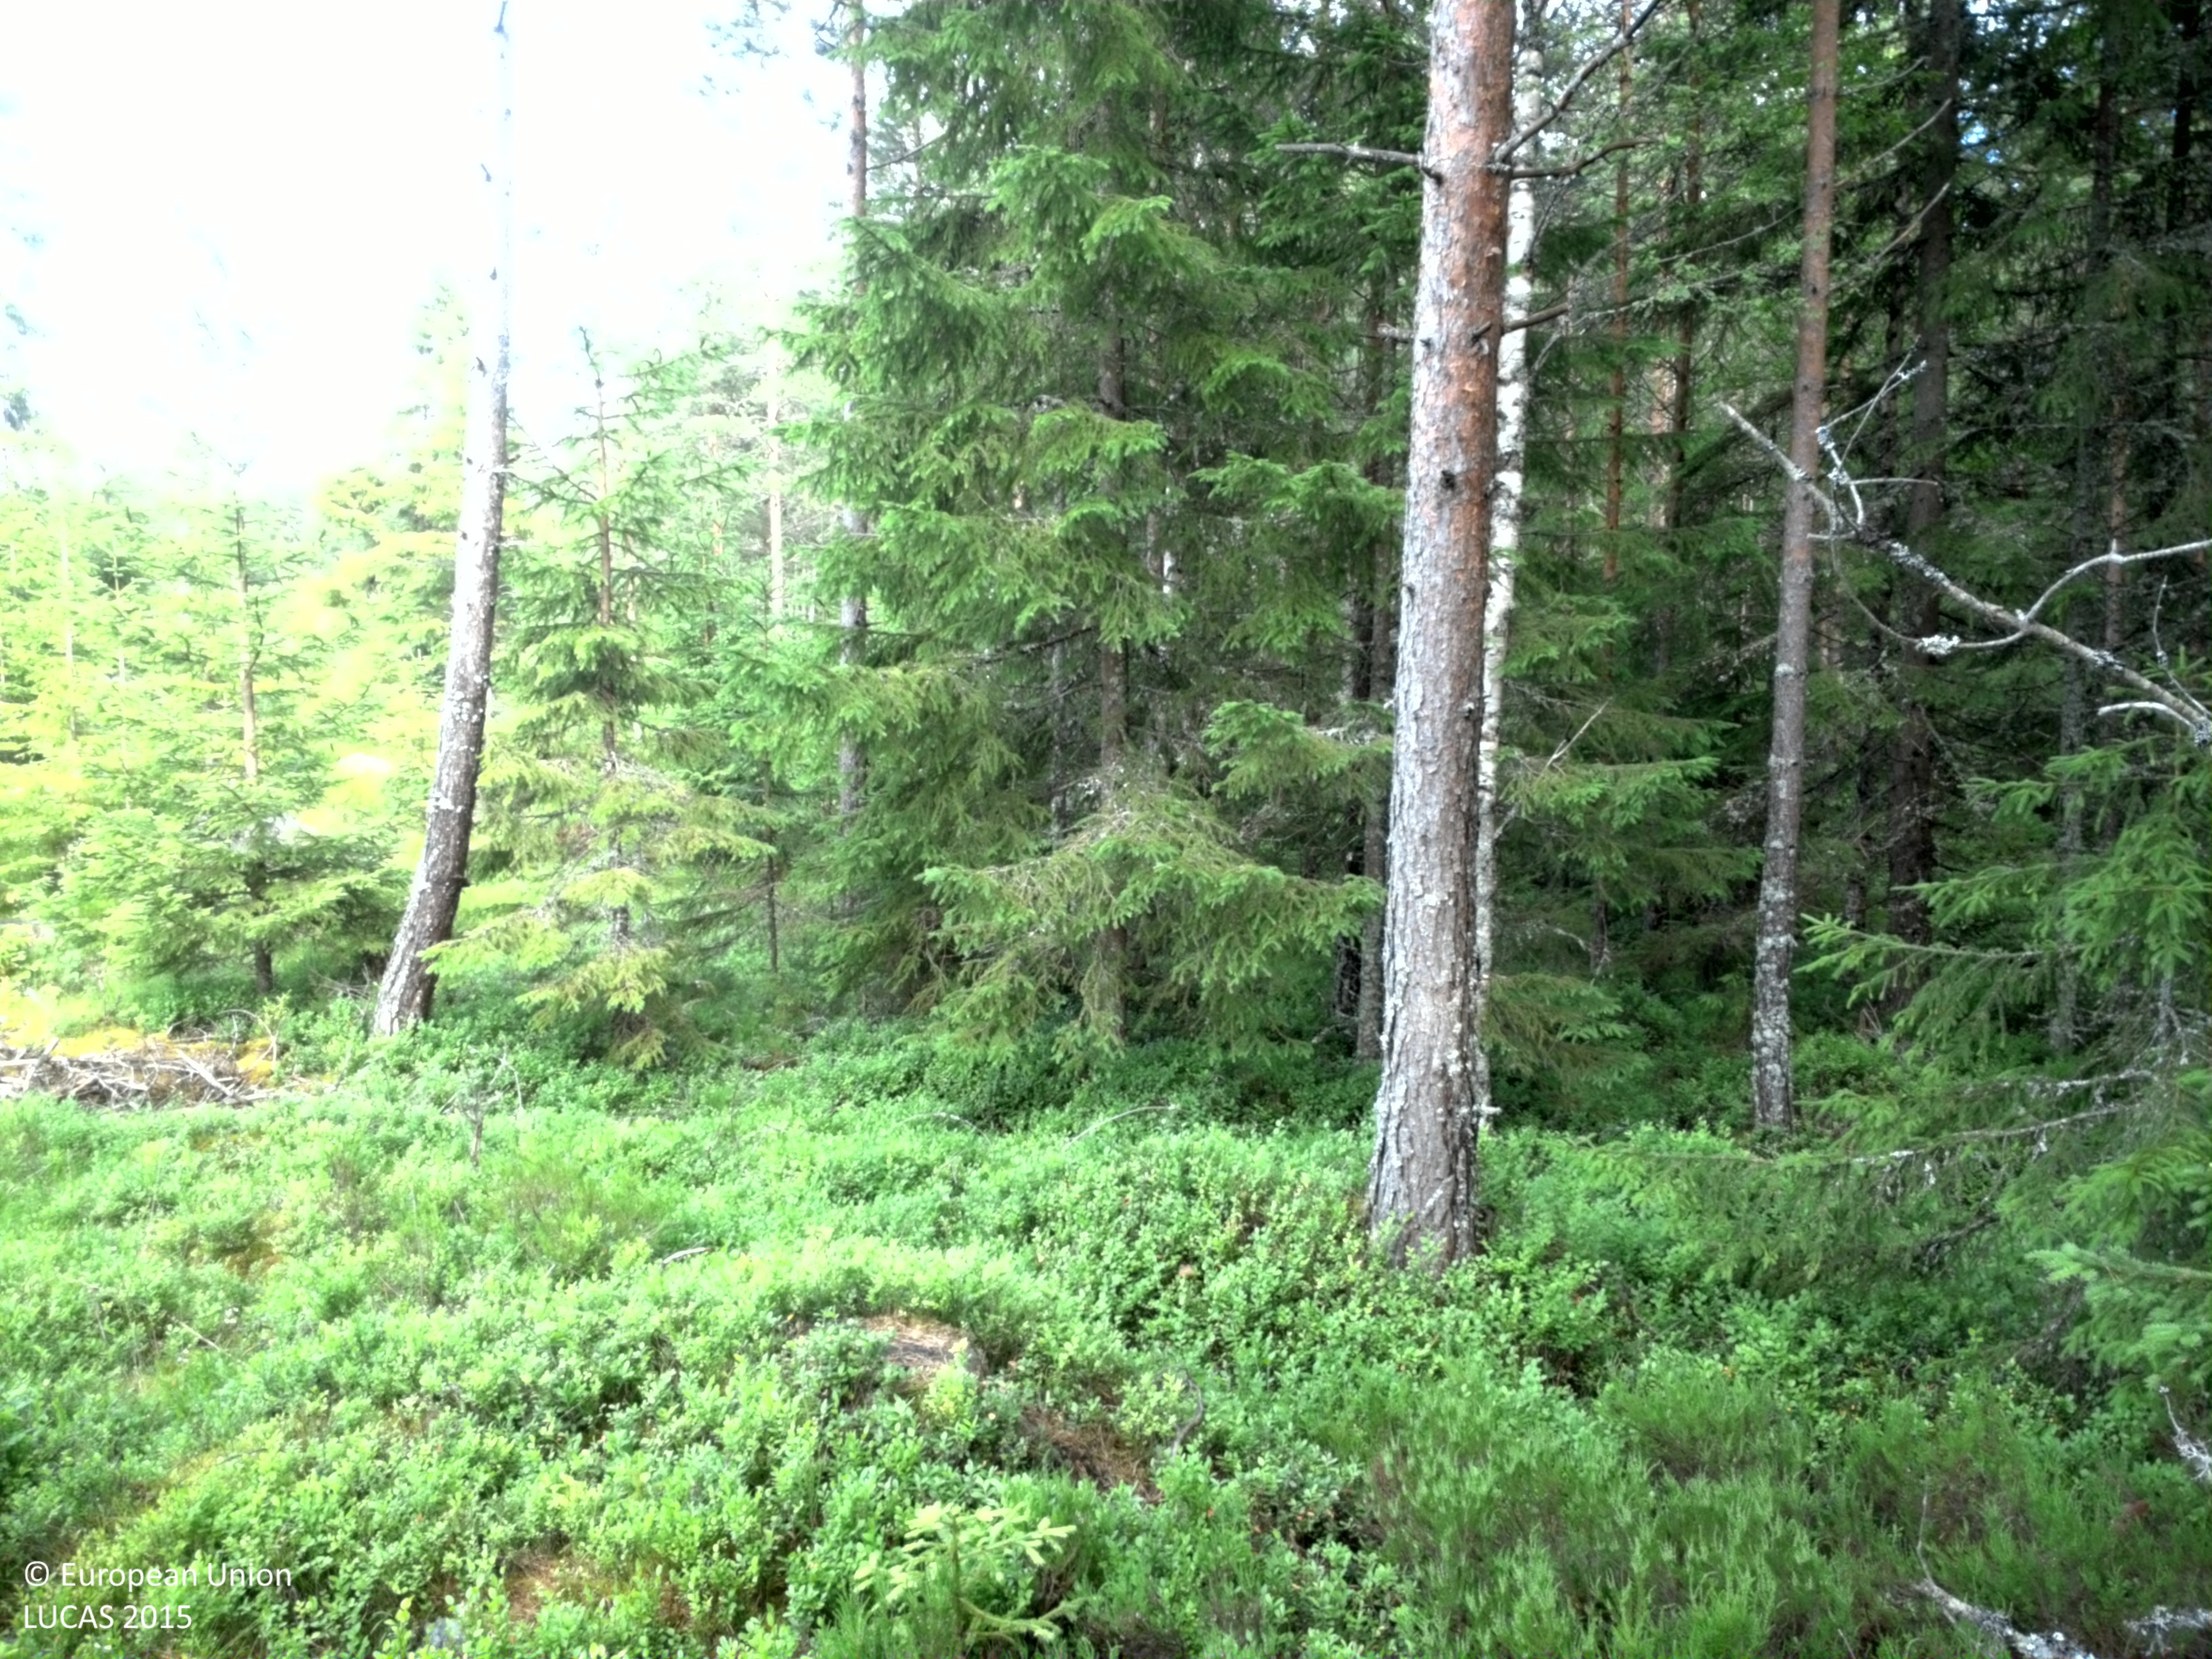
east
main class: Woodland
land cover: Pine dominated coniferous woodland
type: boreal forest
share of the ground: > 75 %
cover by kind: coniferous forest trees 70 %, shrubs 20 %, broadleaved forest trees 10 %
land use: Forestry
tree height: > 5 m
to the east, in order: Pine dominated coniferous woodland; Pine dominated mixed woodland; Pine dominated coniferous woodland; Spruce dominated coniferous woodland; Other mixed woodland
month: July
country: SE
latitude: 59.4544
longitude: 14.6658
